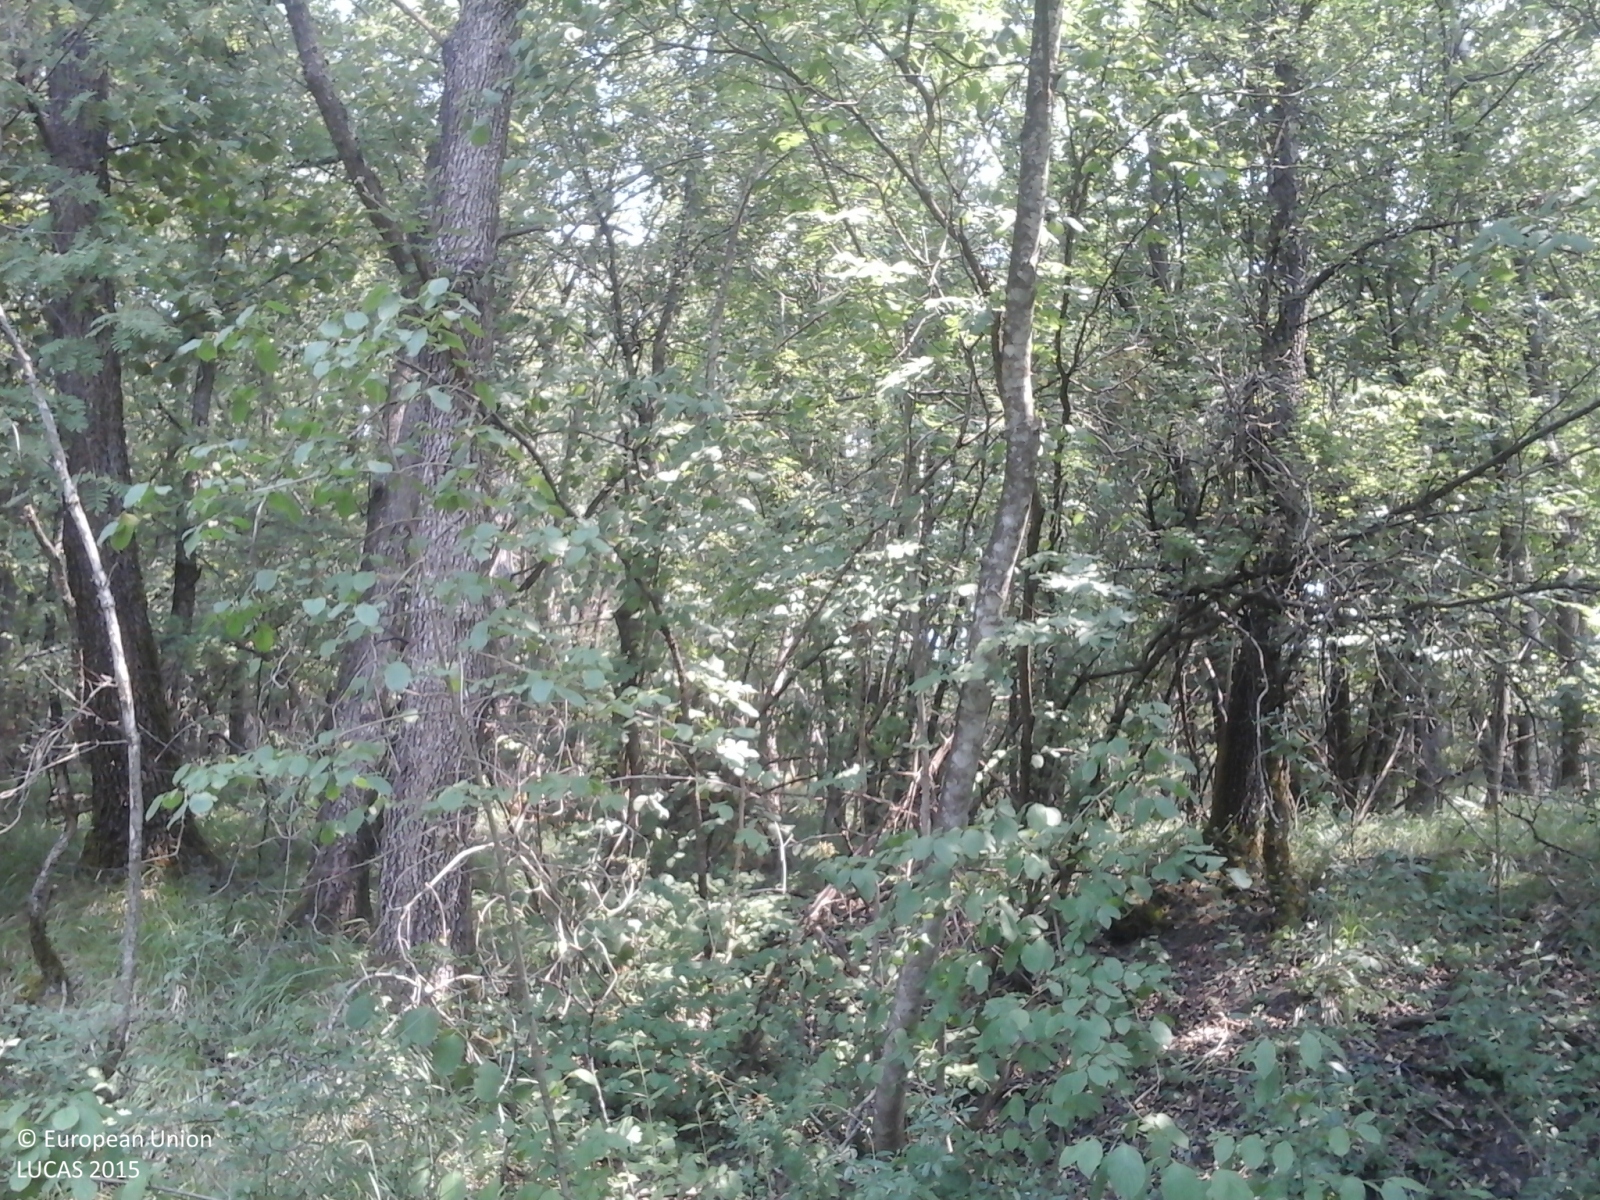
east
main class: Woodland
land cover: Broadleaved woodland
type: thermophilous deciduous forest
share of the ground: > 75 %
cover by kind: broadleaved forest trees 90 %, coniferous forest trees 10 %
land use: Forestry
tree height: > 5 m
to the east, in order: Broadleaved woodland; Lucerne; Single bushes/trees; Lucerne; Managed hedges; Fences; Broadleaved woodland
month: July
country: IT
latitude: 44.4582
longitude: 10.3386
